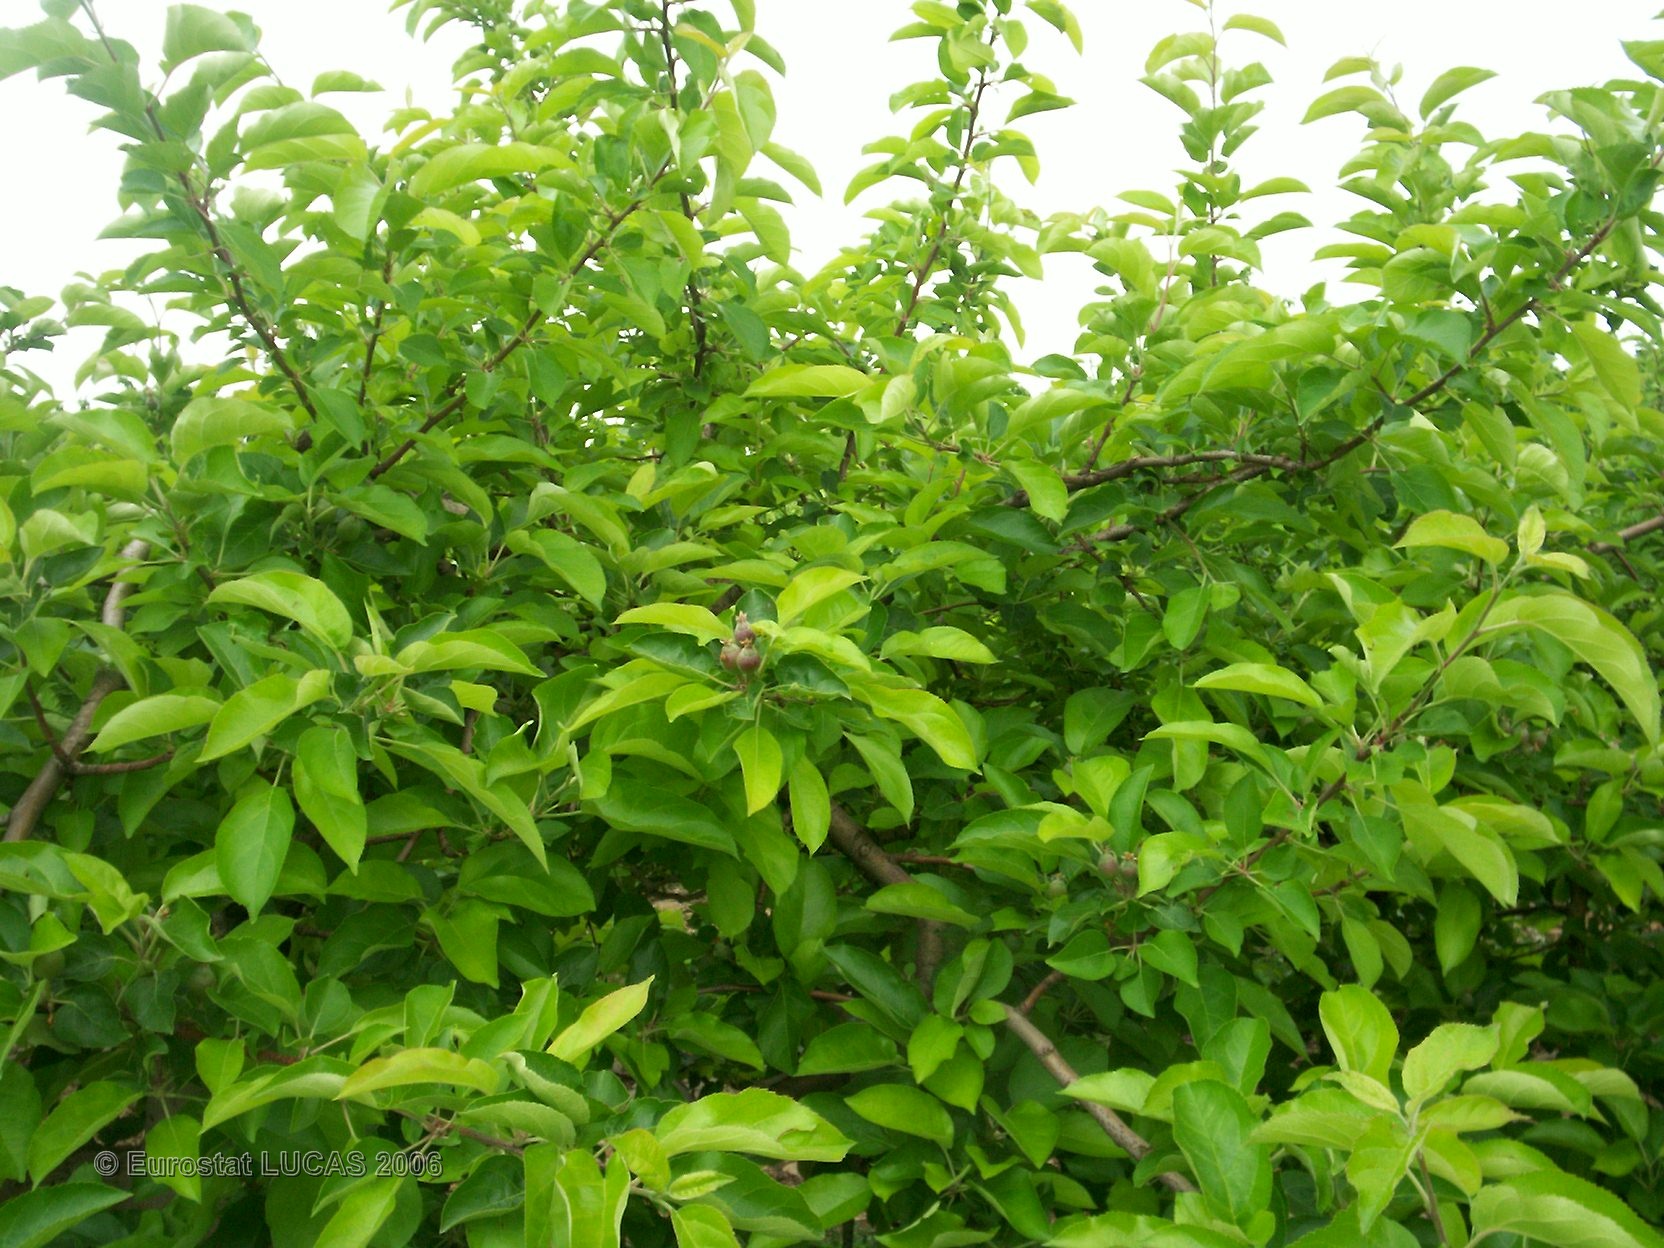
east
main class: Cropland
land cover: Pear fruit
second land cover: Grassland with sparse tree/shrub cover
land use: Agriculture (excluding fallow land and kitchen gardens)
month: May
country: FR
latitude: 45.6450
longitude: 4.7560
